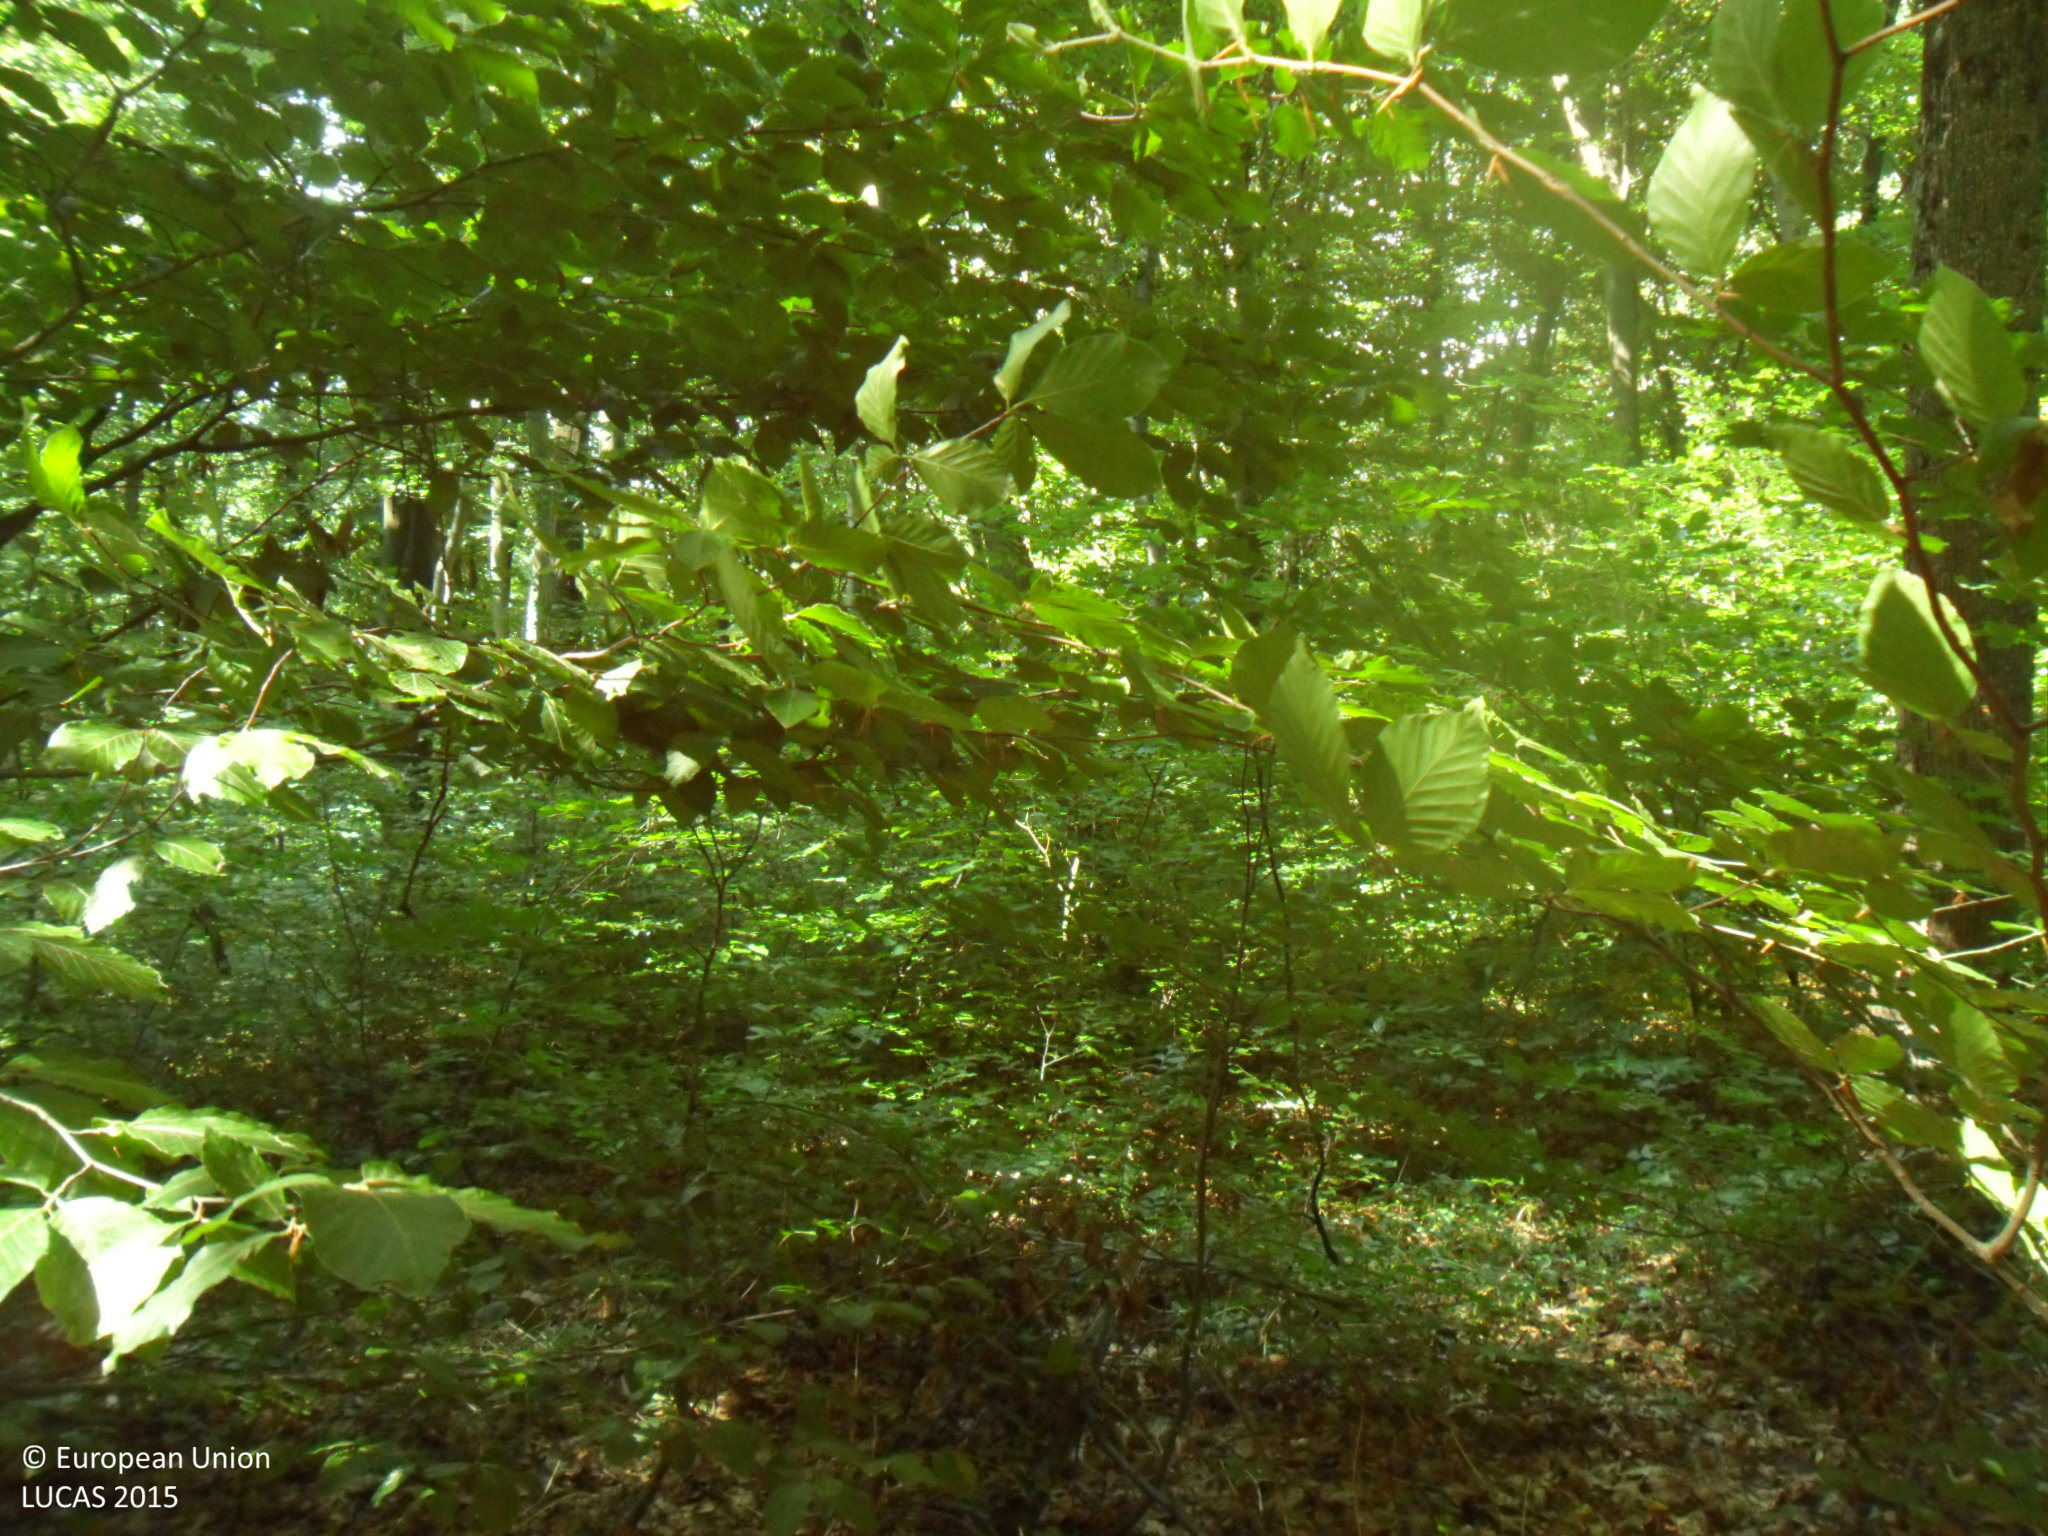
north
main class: Woodland
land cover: Broadleaved woodland
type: beech forest
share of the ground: > 75 %
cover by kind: broadleaved forest trees 95 %, shrubs 5 %
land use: Amenities, museums, leisure
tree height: > 5 m
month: June
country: BG
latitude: 43.2683
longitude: 26.8796
